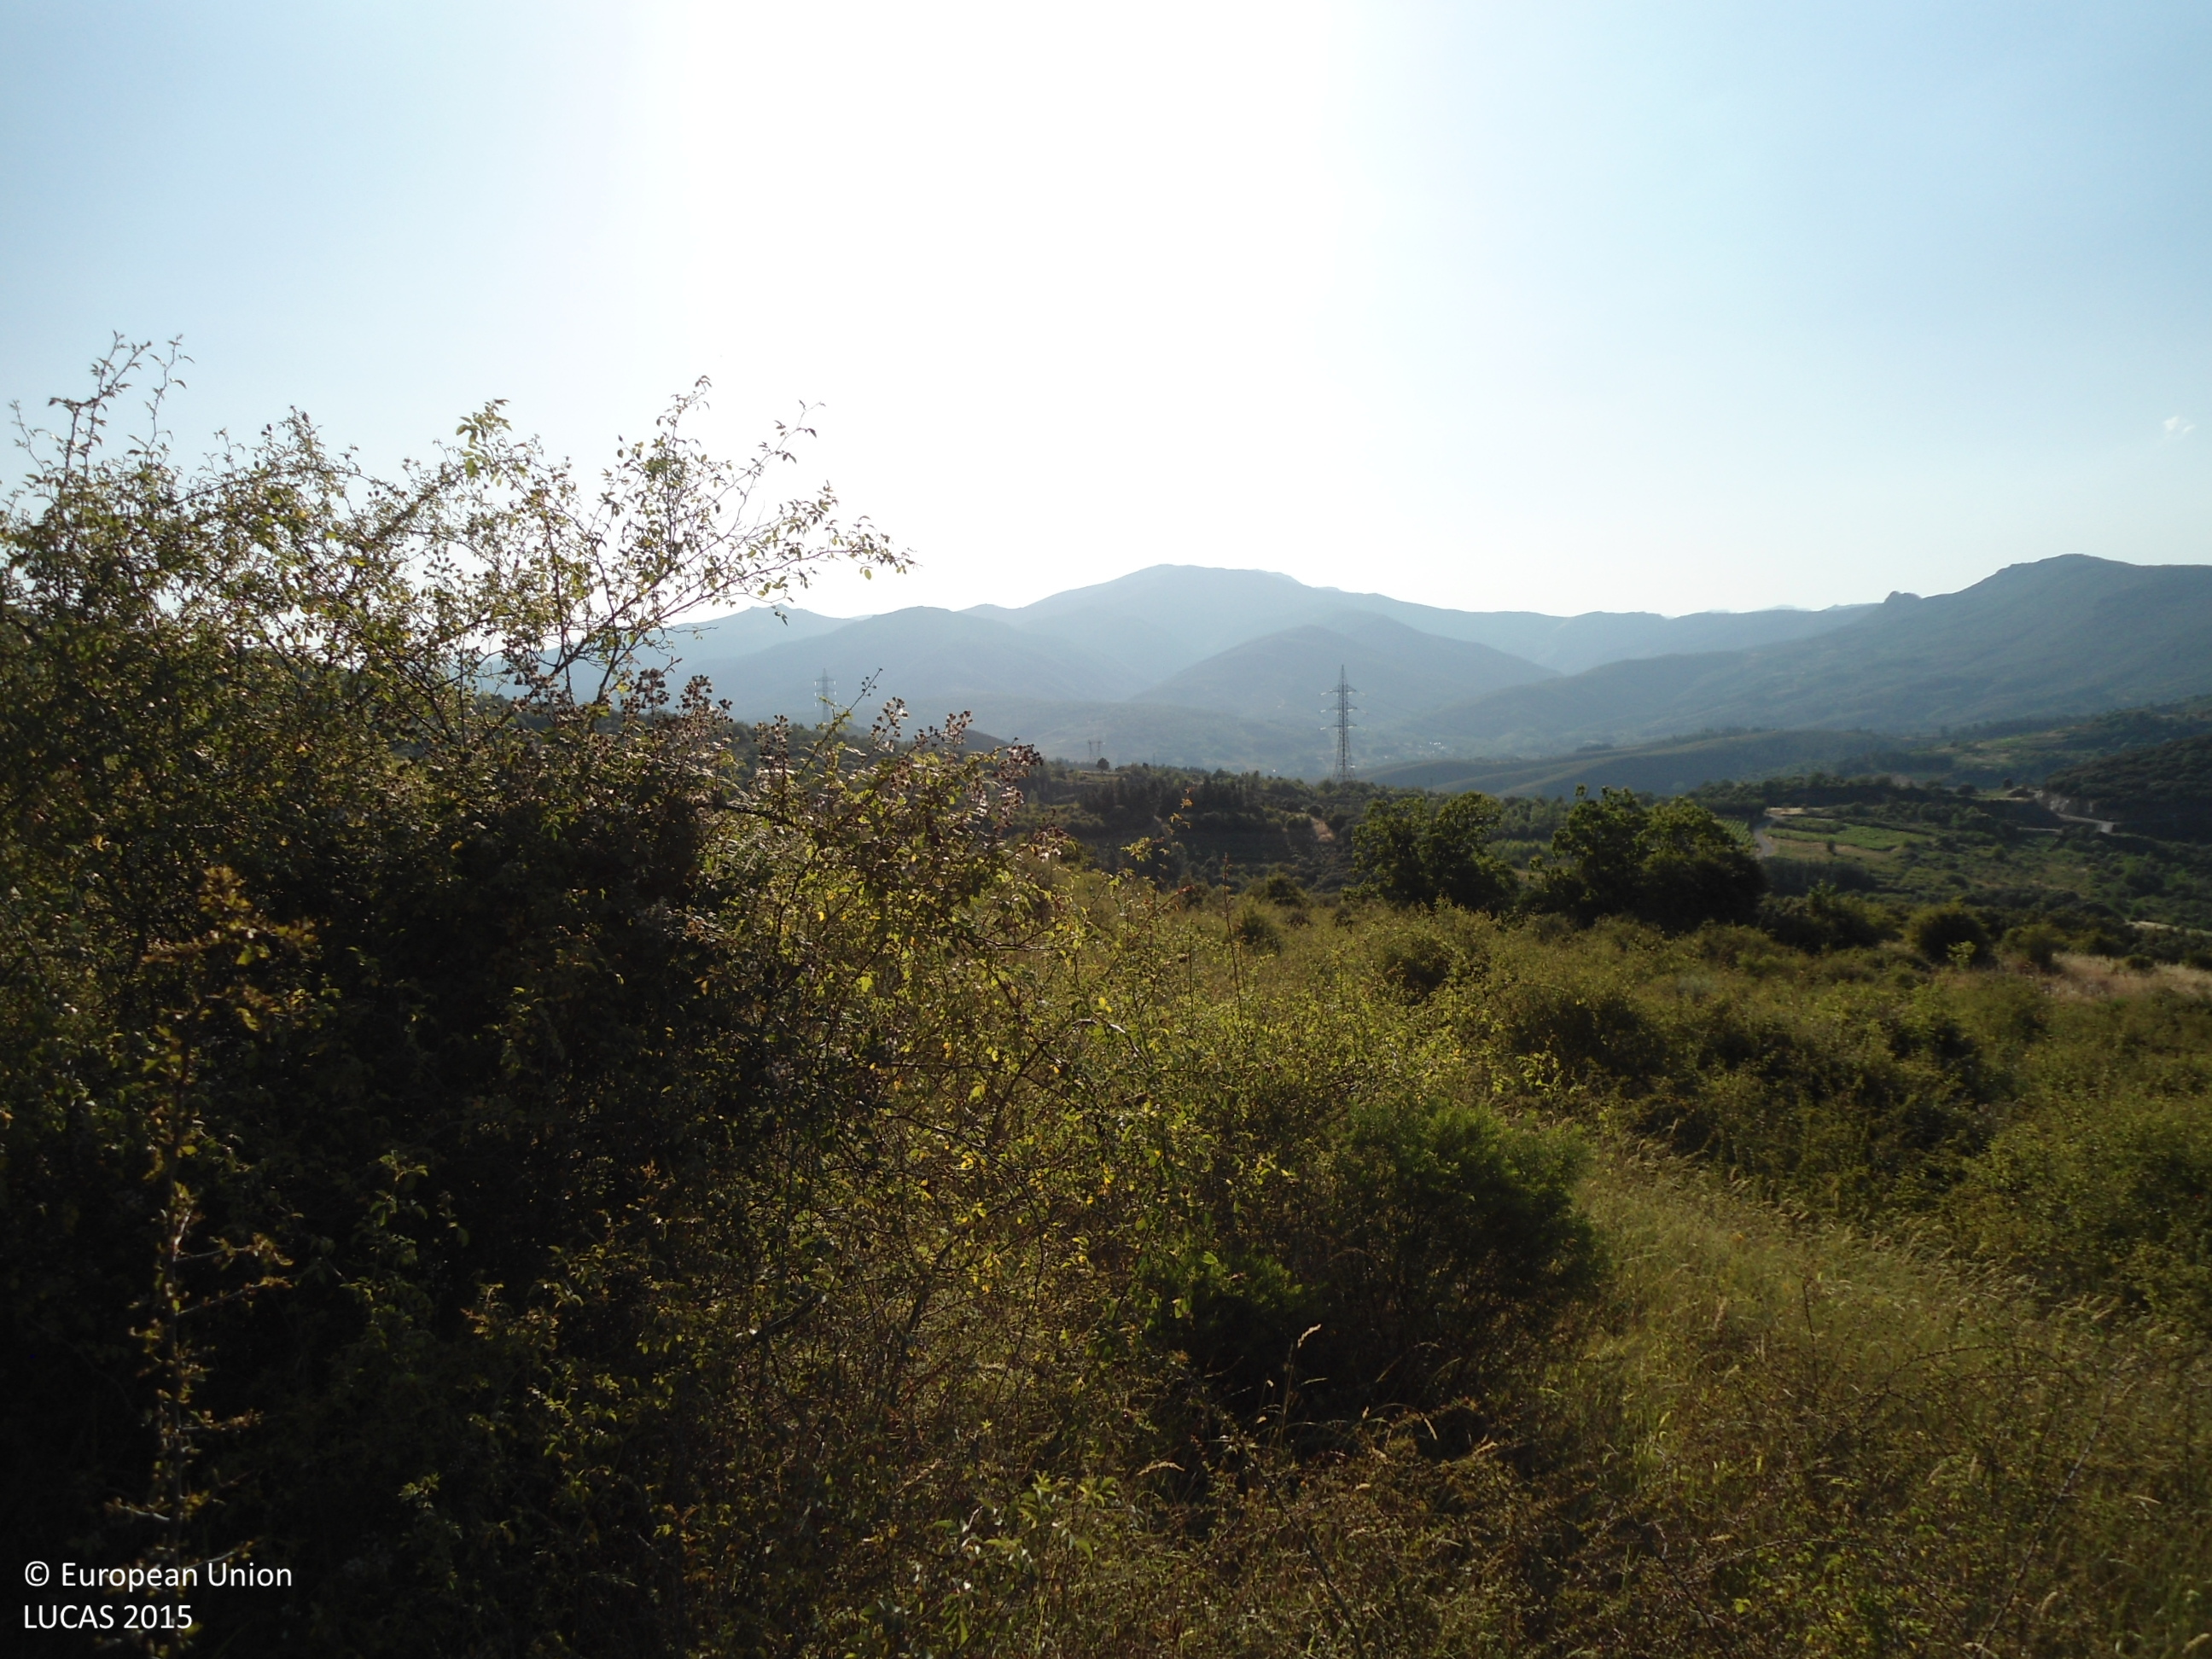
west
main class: Shrubland
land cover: Shrubland without tree cover
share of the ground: > 75 %
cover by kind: shrubs 85 %, herbaceous plants 15 %
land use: Semi-natural and natural areas not in use
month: June
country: ES
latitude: 42.4642
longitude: -6.8468
